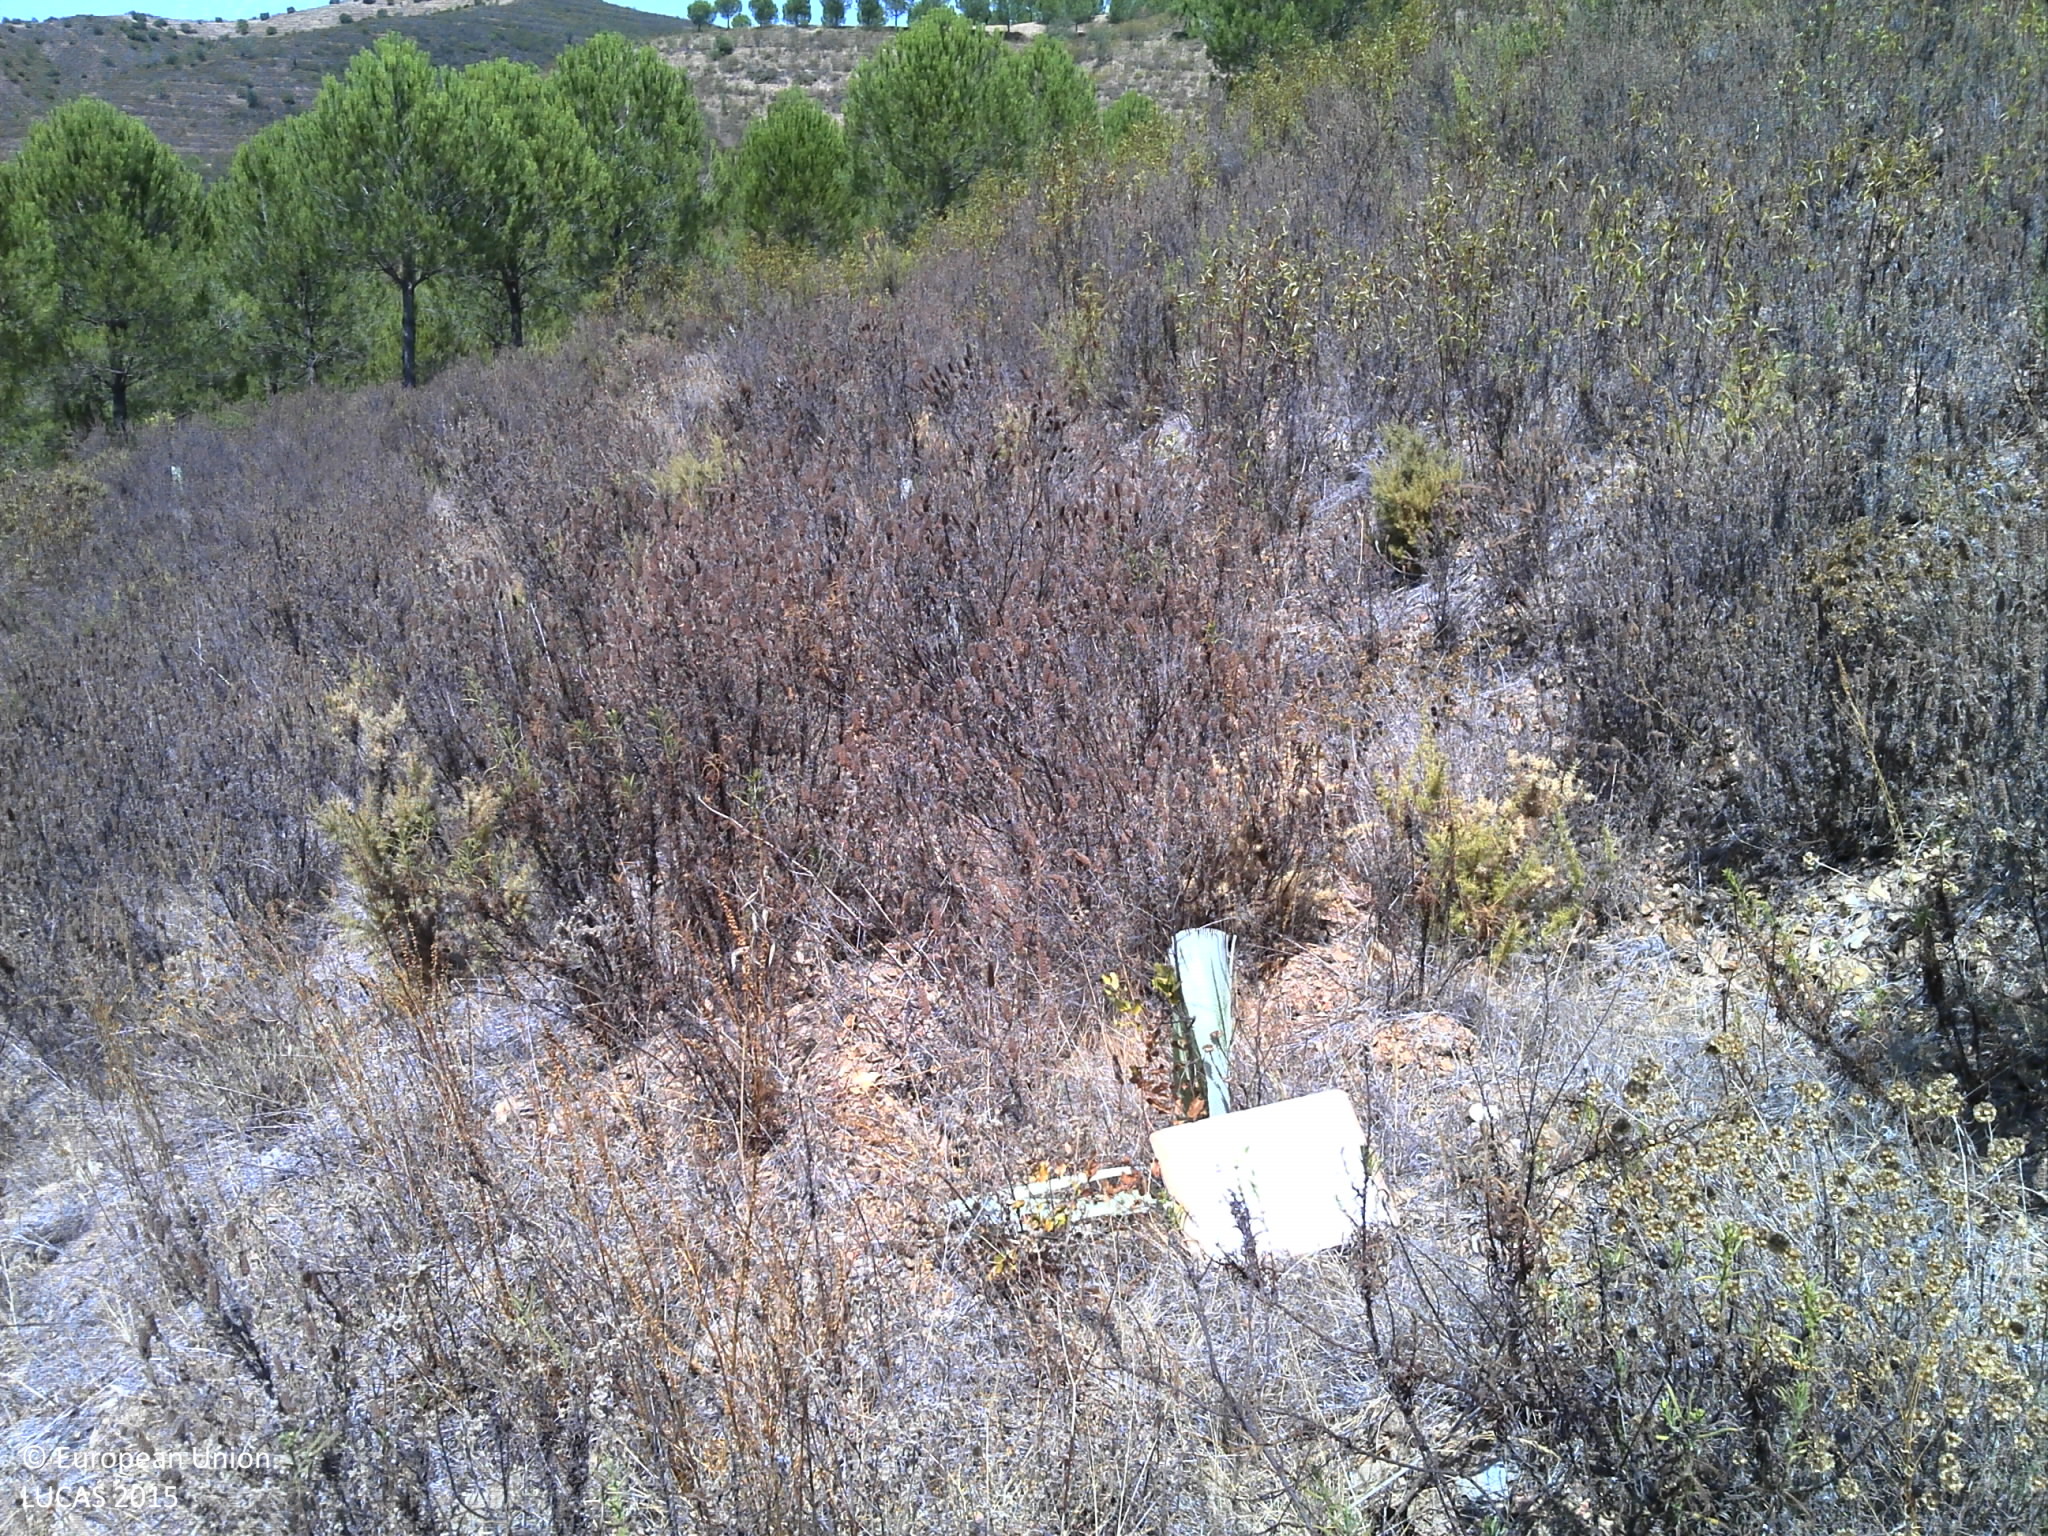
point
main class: Grassland
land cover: Grassland with sparse tree/shrub cover
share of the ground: 50 - 75 %
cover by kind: herbaceous plants 60 %, unconsolidated bare surface 35 %, broadleaved forest trees 5 %
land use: Forestry
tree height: < 5 m
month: September
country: PT
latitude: 37.3664
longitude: -8.1899
